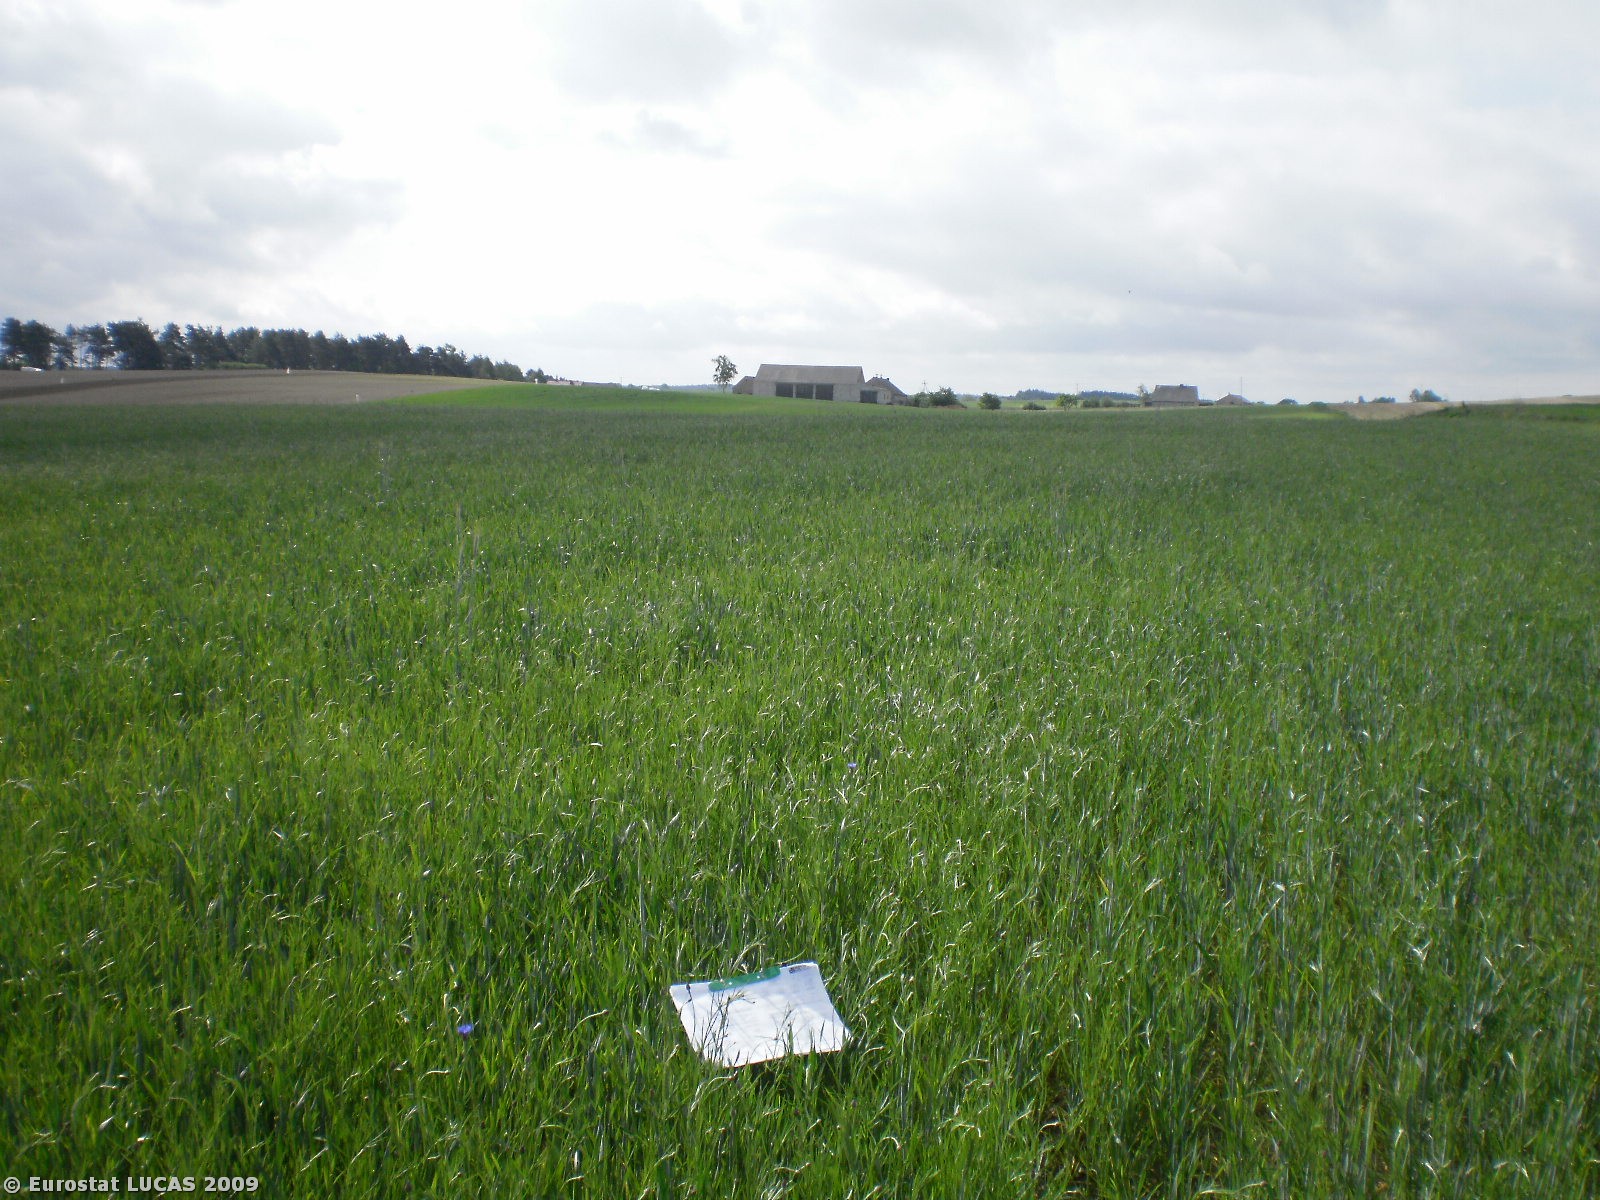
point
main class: Cropland
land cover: Rye
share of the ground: > 75 %
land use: Agriculture (excluding fallow land and kitchen gardens)
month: May
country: PL
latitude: 53.5542
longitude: 17.6960
